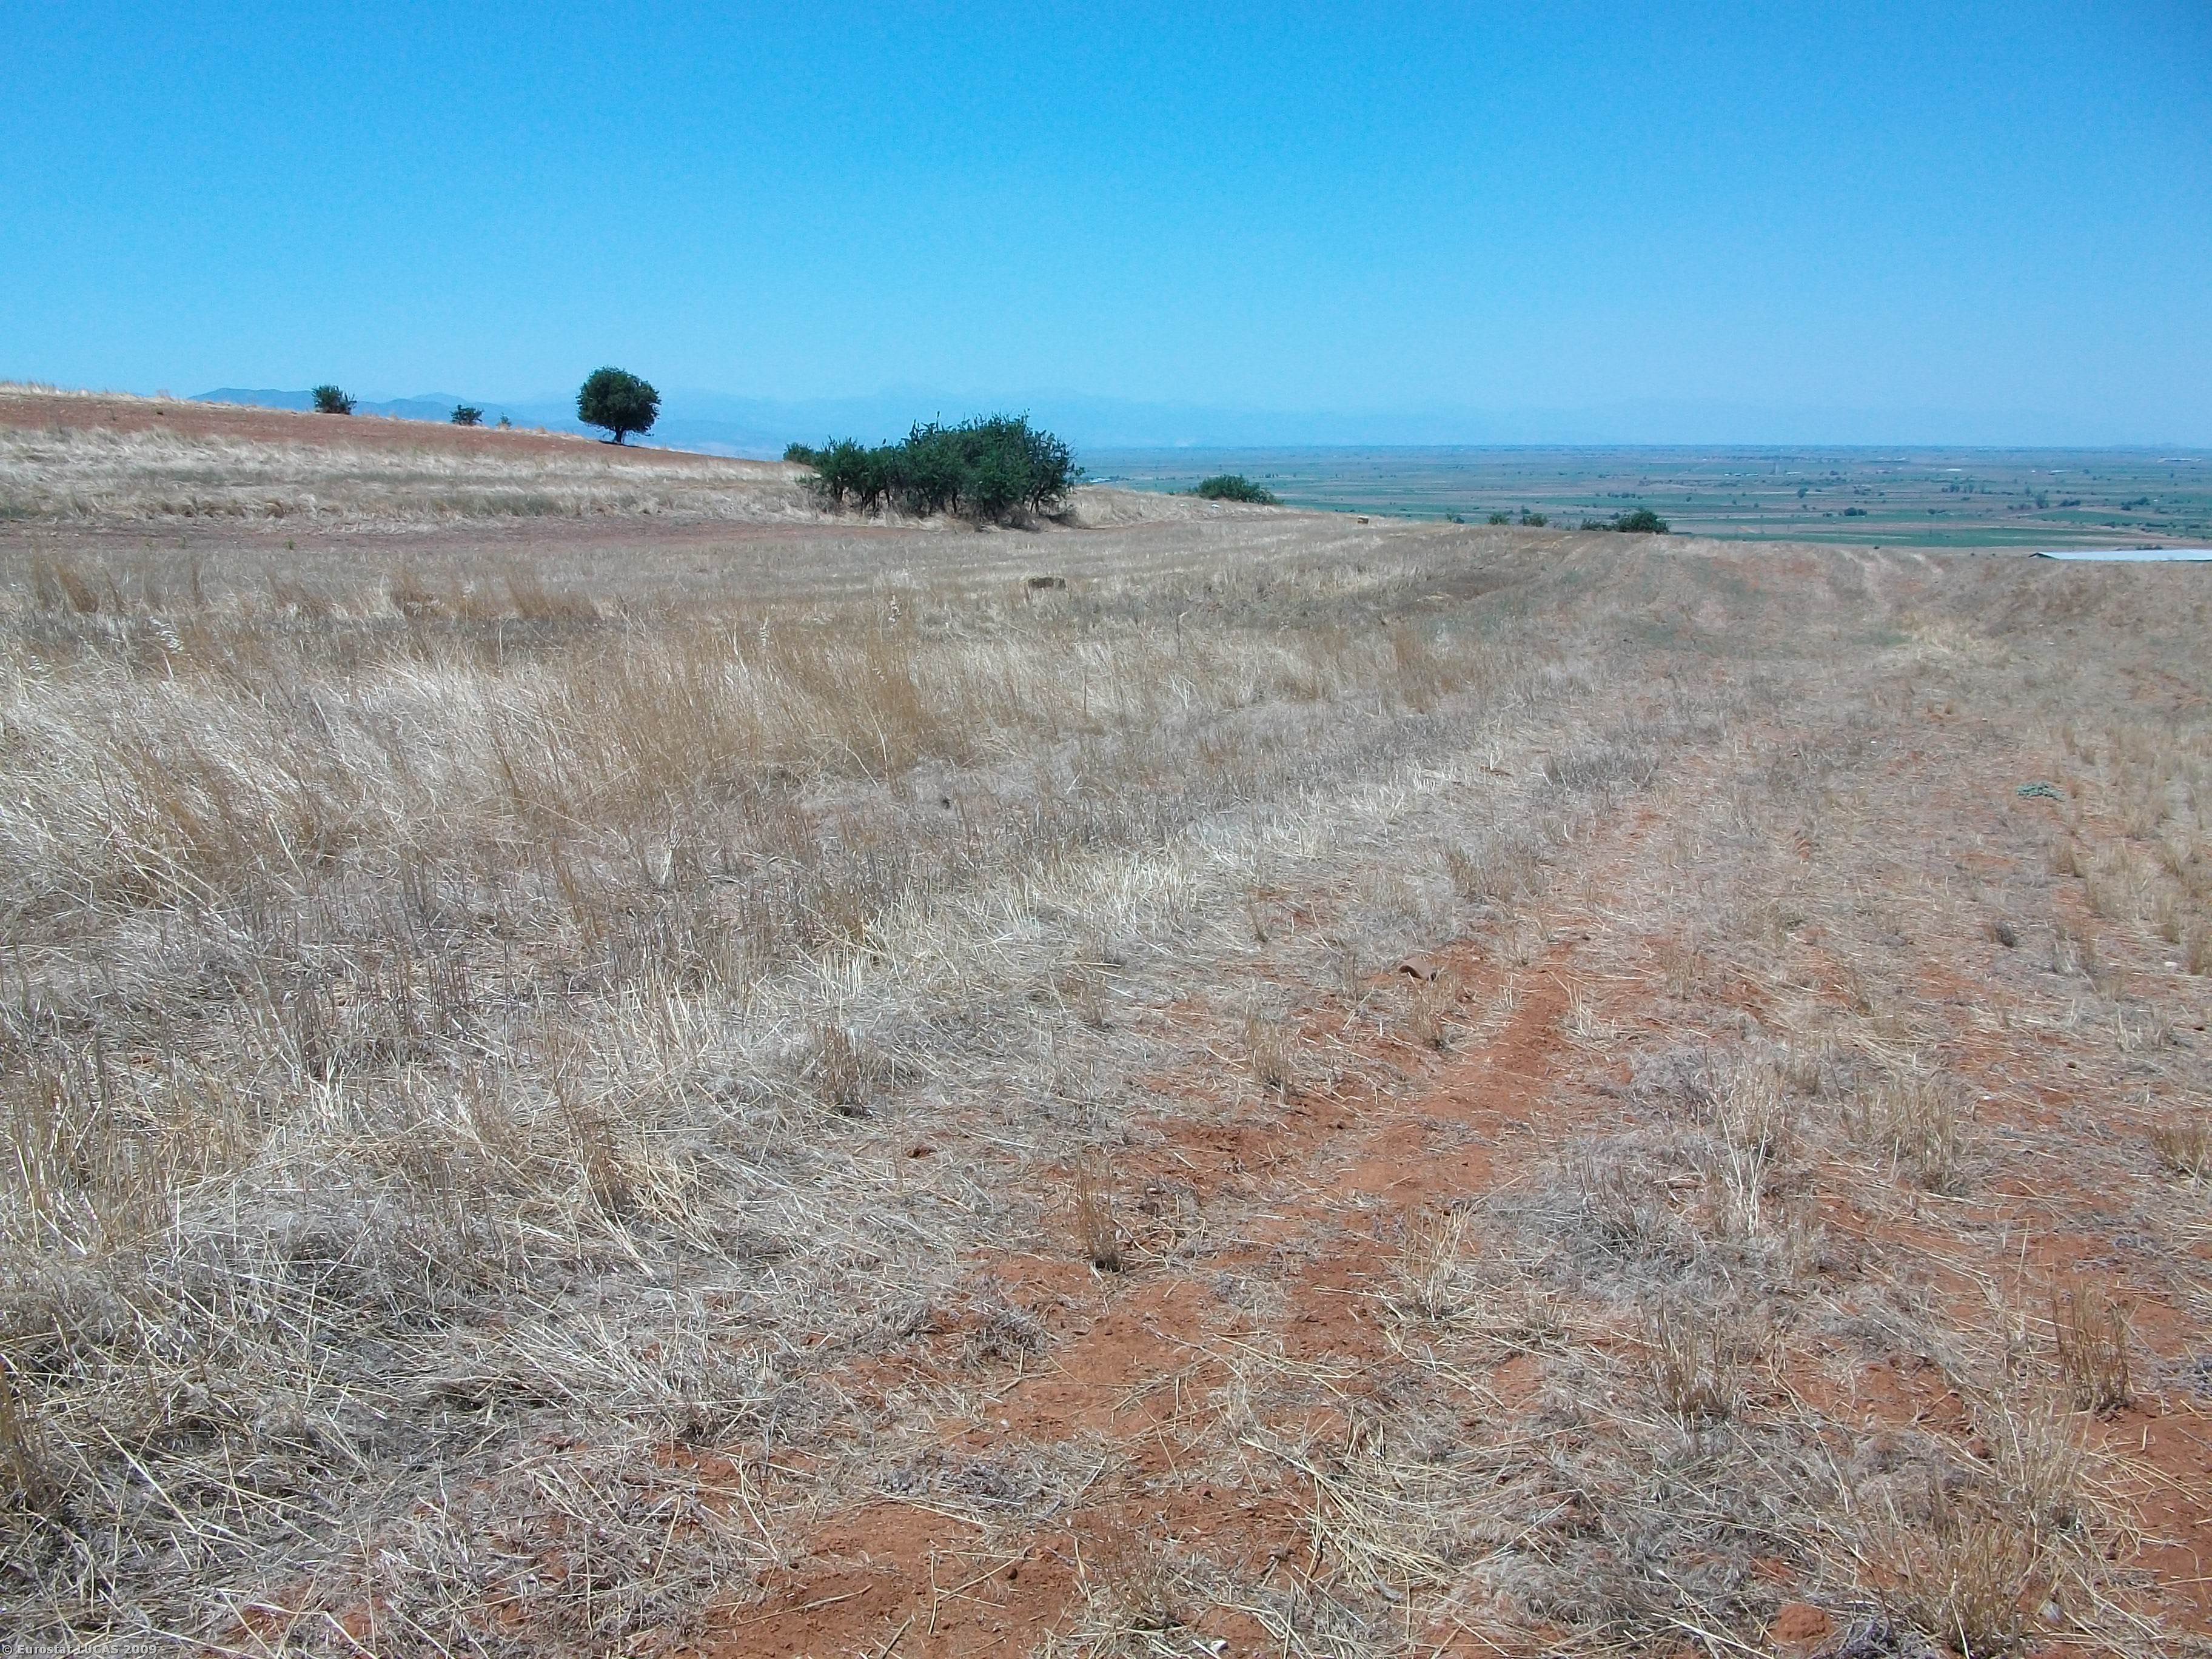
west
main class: Cropland
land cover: Durum wheat
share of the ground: > 75 %
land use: Agriculture (excluding fallow land and kitchen gardens)
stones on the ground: 10 - 25 %
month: July
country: GR
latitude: 39.1957
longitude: 22.3147
